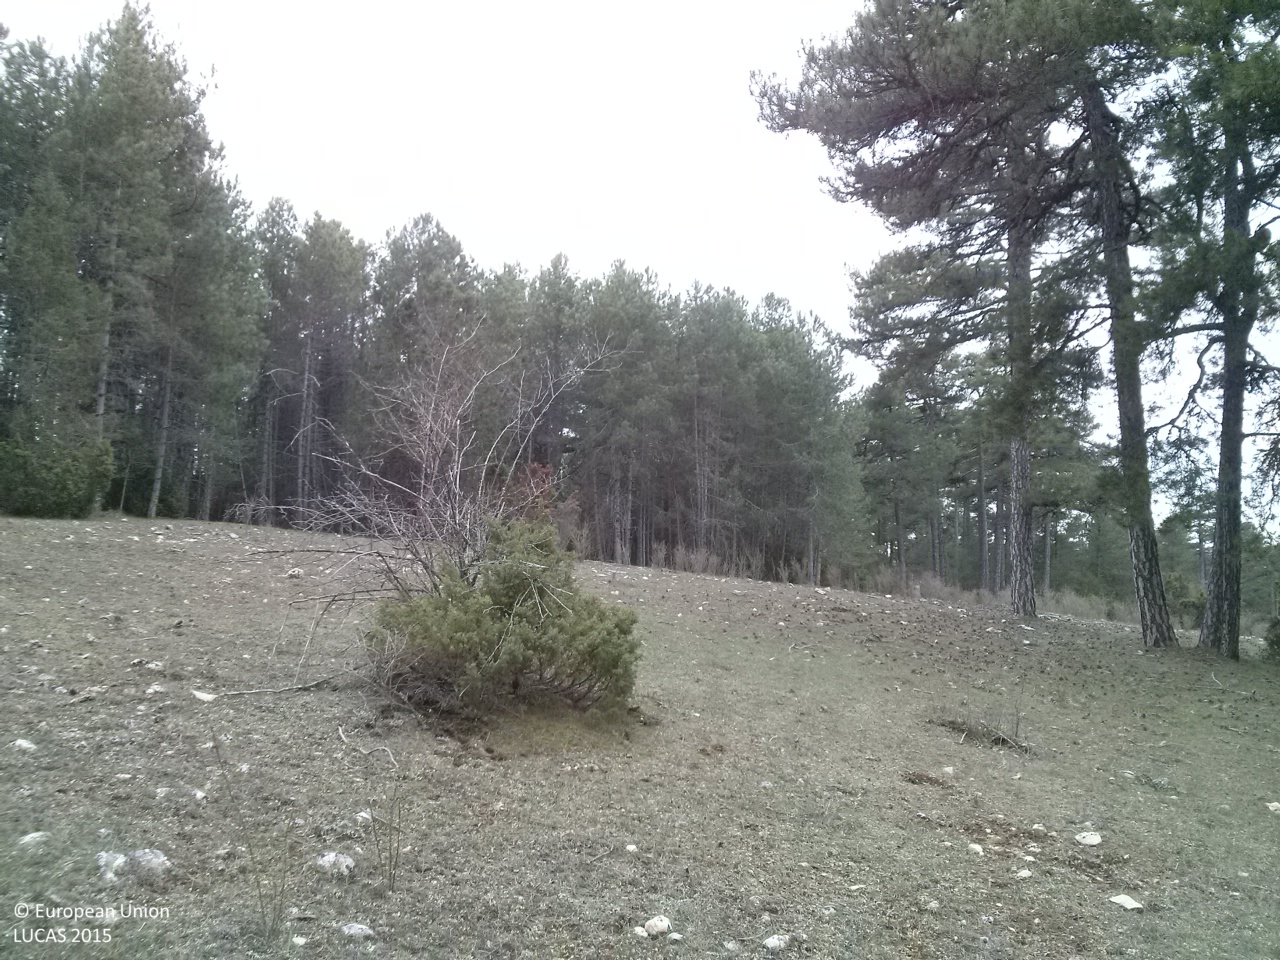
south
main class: Woodland
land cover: Pine dominated coniferous woodland
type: coniferous forest of the mediterranean region
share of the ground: 25 - 50 %
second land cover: Grassland without tree/shrub cover
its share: > 75 %
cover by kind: herbaceous plants 55 %, coniferous forest trees 40 %, shrubs 5 %
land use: Forestry
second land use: Agriculture (excluding fallow land and kitchen gardens)
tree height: > 5 m
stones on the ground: 10 - 25 %
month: April
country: ES
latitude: 40.2797
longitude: -1.9781
